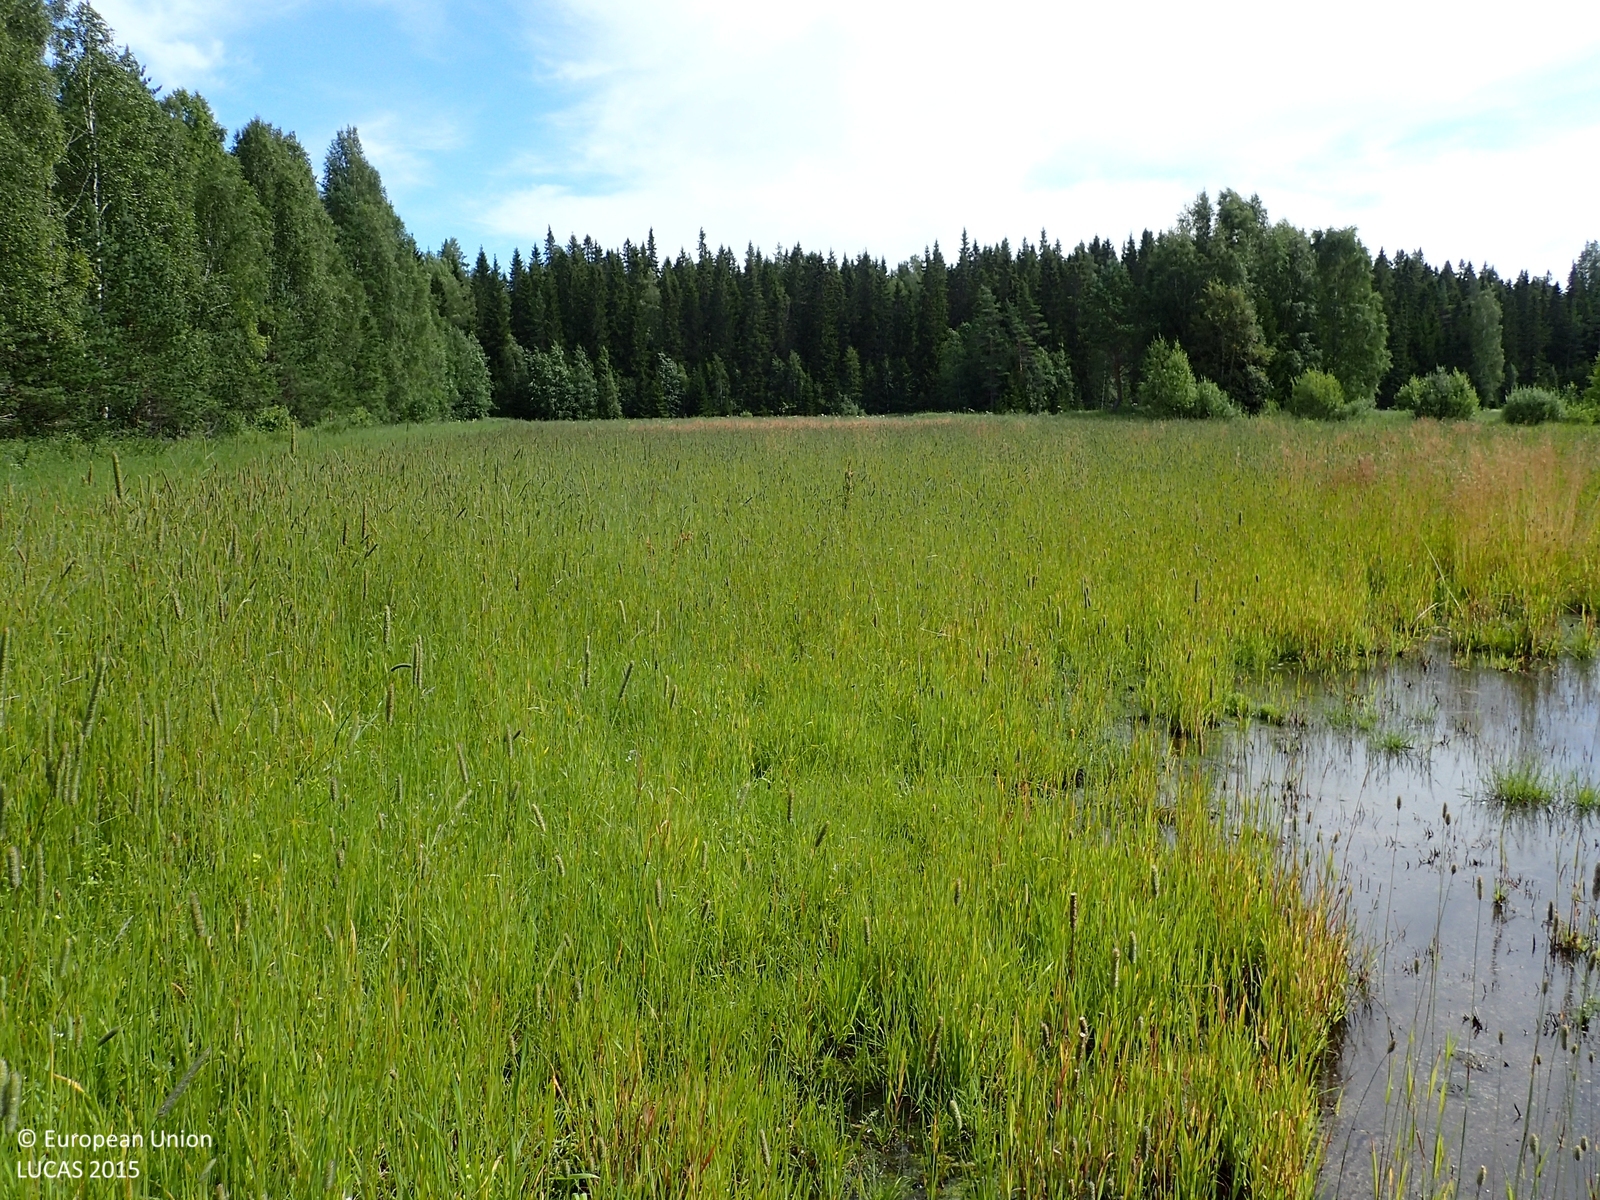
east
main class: Grassland
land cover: Spontaneously vegetated surfaces
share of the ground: > 75 %
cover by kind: herbaceous plants 100 %
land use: Fallow land
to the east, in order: Spontaneously vegetated surfaces; Shruby margins; Ditches and canals; Shruby margins; Spontaneously vegetated surfaces; Abandoned hedges; Ditches and canals; Spruce dominated coniferous woodland
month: August
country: FI
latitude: 62.8374
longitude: 21.8451
